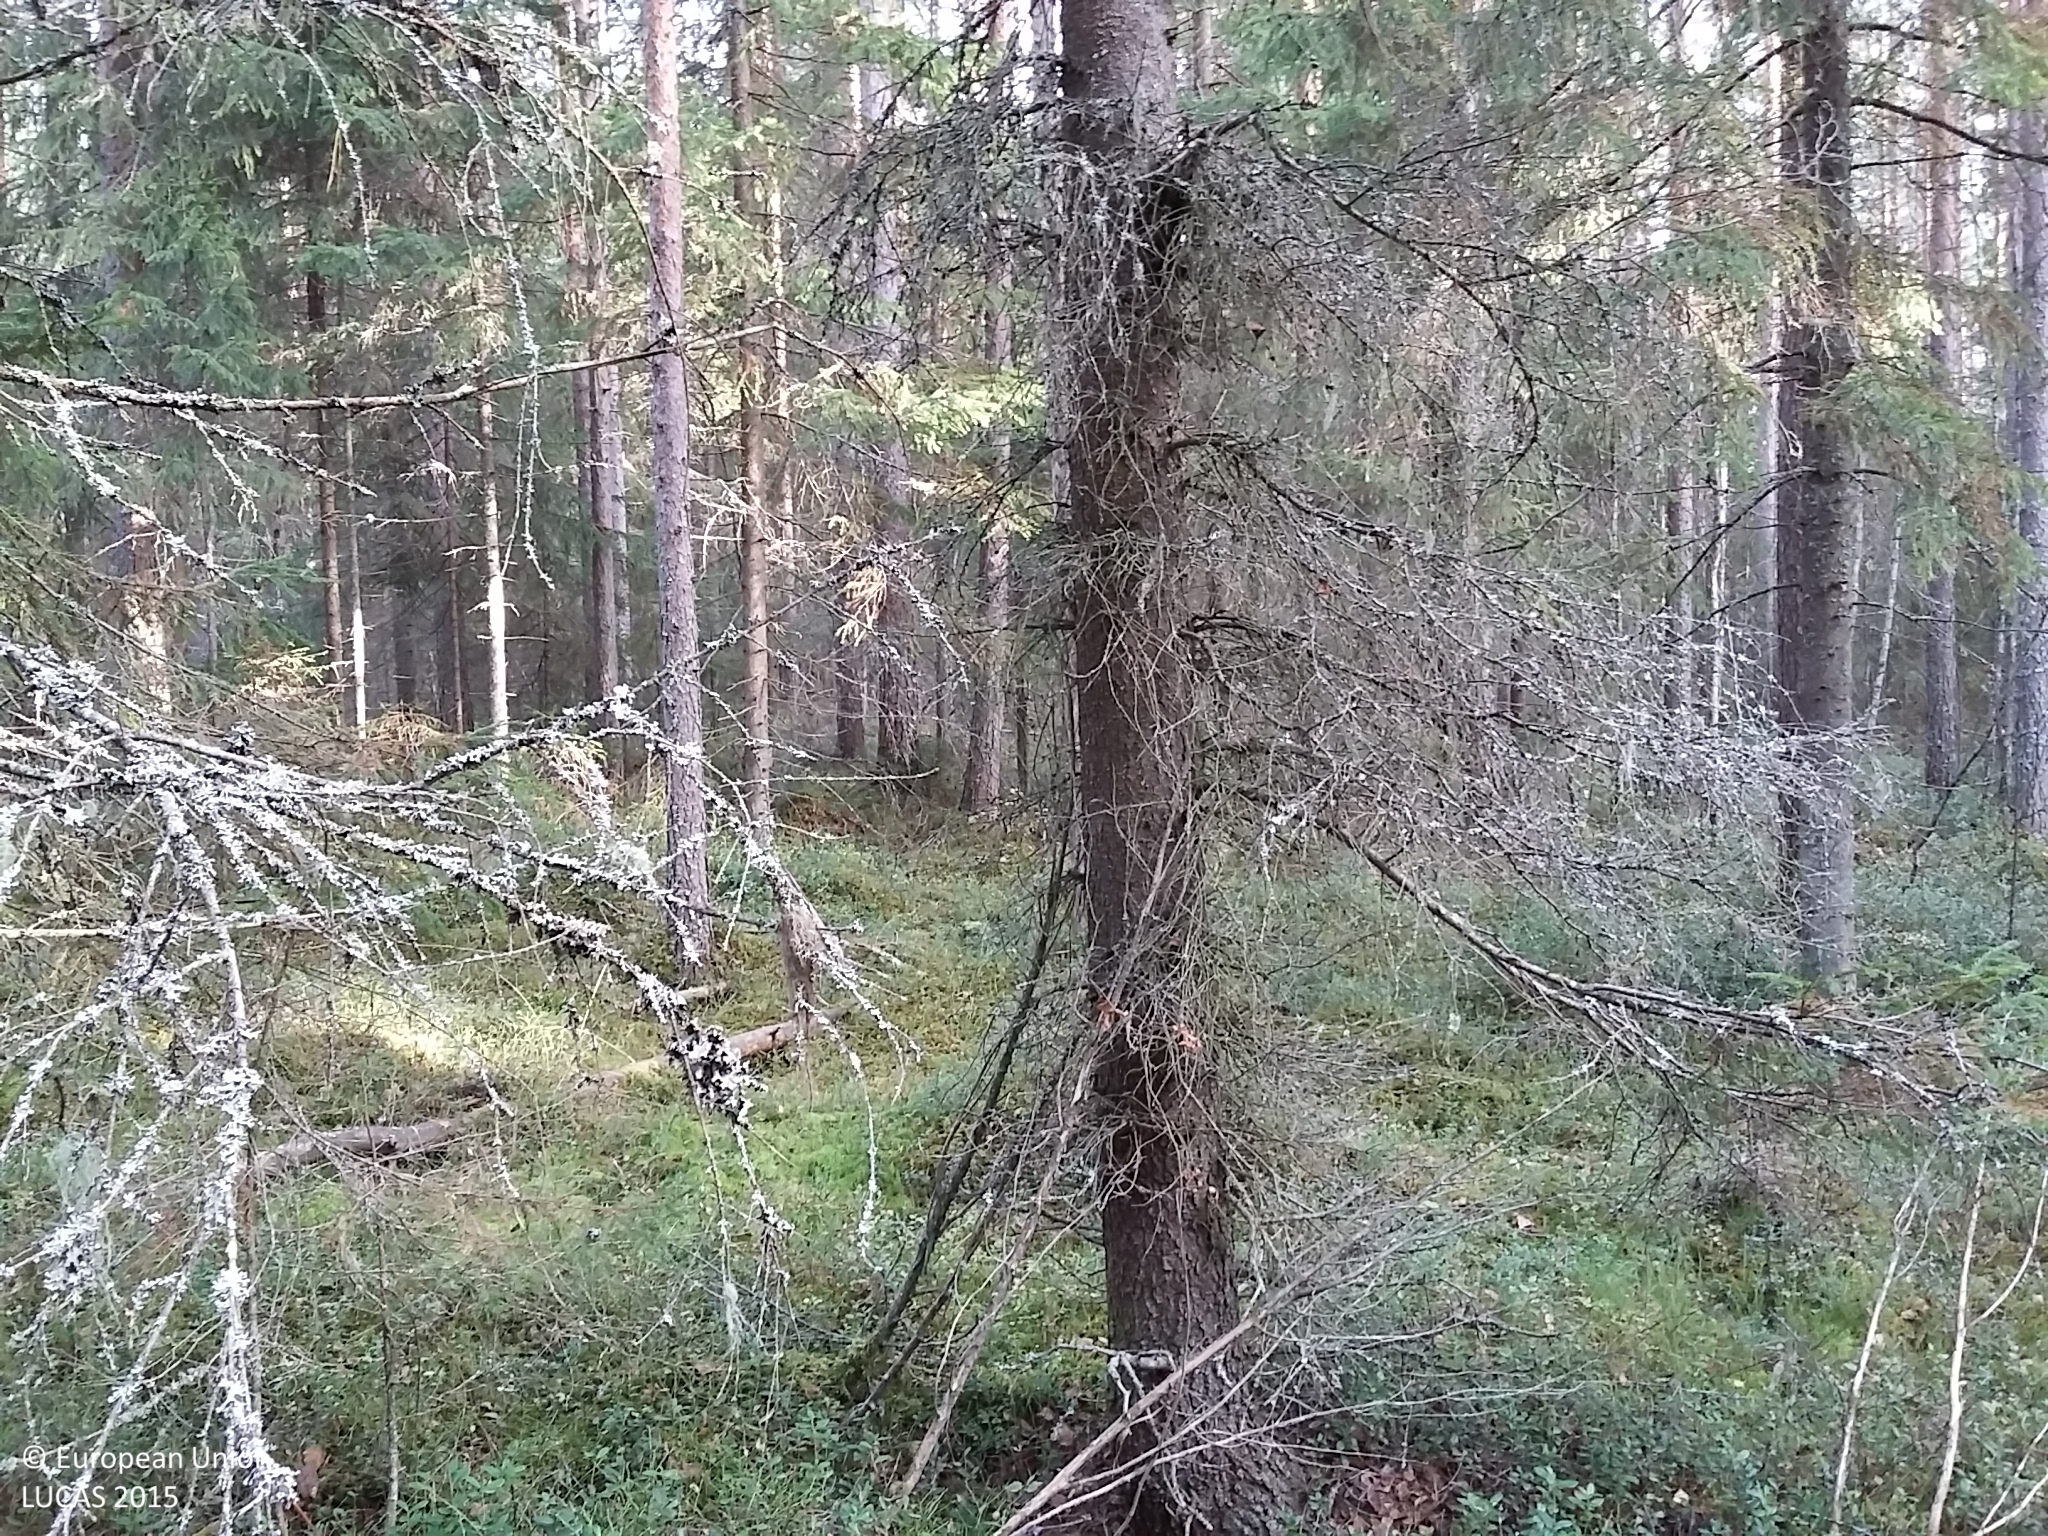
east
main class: Woodland
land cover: Spruce dominated coniferous woodland
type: boreal forest
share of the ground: > 75 %
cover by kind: coniferous forest trees 80 %, broadleaved forest trees 10 %, herbaceous plants 5 %, lichens and mosses 5 %
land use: Forestry
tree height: > 5 m
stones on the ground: < 10 %
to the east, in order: Spruce dominated coniferous woodland; Other coniferous woodland; Grass margins; Tracks; Grass margins; Ditches and canals; Other coniferous woodland; Ditches and canals; Spruce dominated coniferous woodland; Tracks; Grassland without tree/shrub cover; Other coniferous woodland; Spruce dominated coniferous woodland; Ditches and canals; Other coniferous woodland
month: October
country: FI
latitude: 63.9593
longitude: 24.9679
